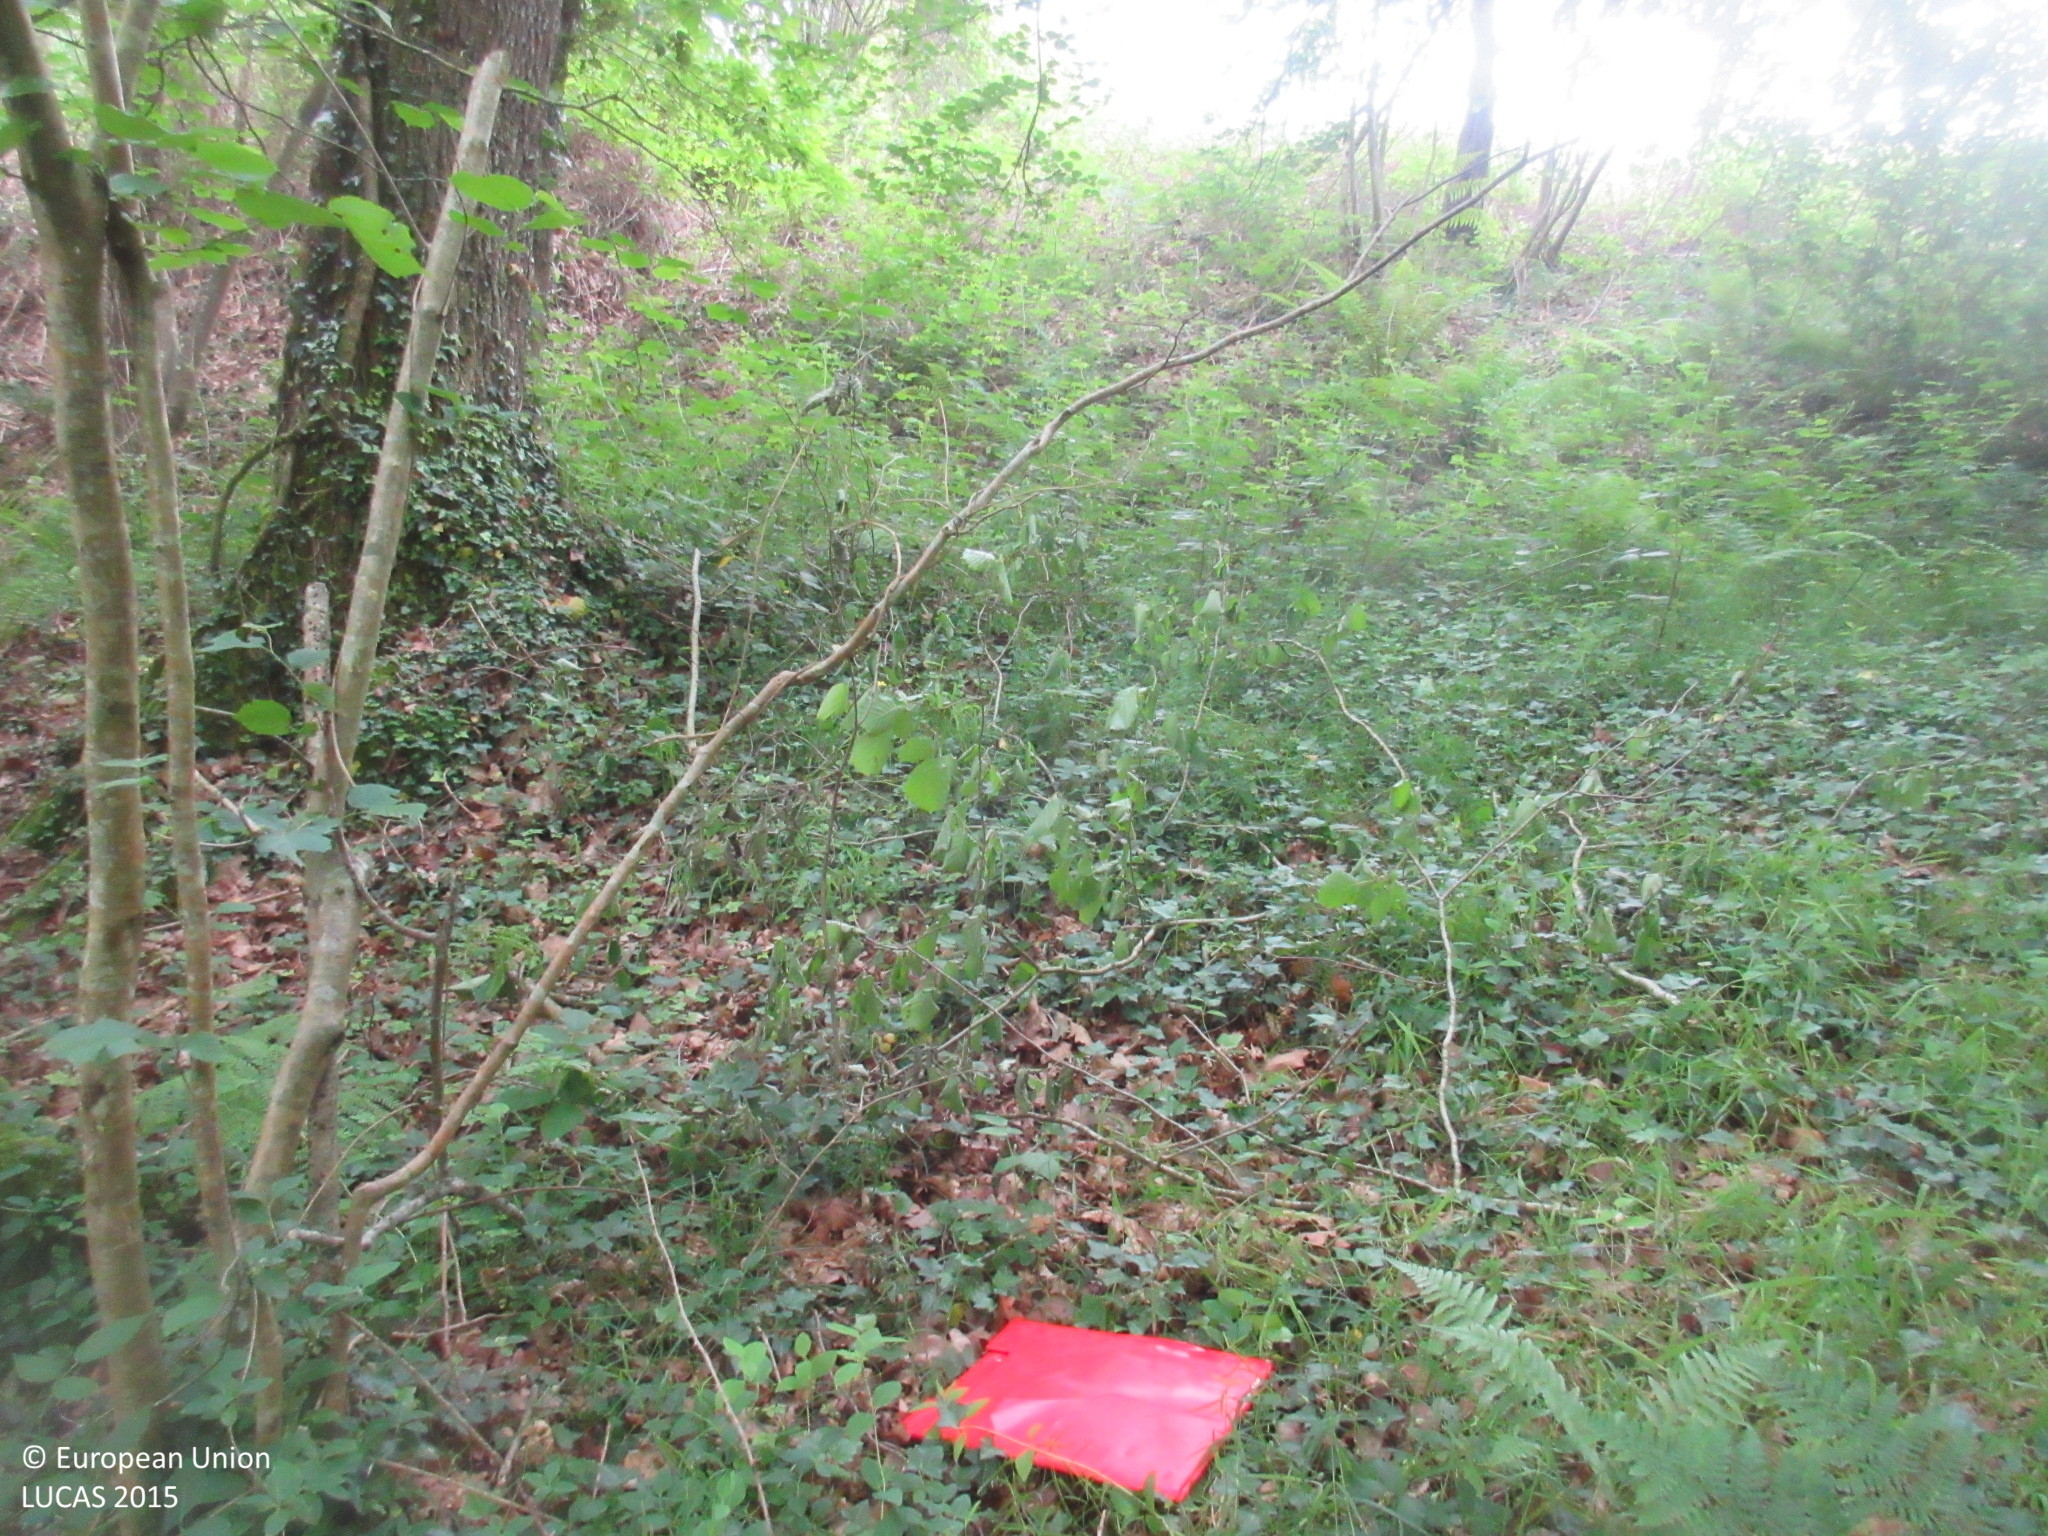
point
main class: Woodland
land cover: Broadleaved woodland
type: floodplain forest
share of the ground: > 75 %
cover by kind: broadleaved forest trees 100 %
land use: Semi-natural and natural areas not in use
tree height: > 5 m
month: June
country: ES
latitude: 43.2962
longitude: -4.1921
